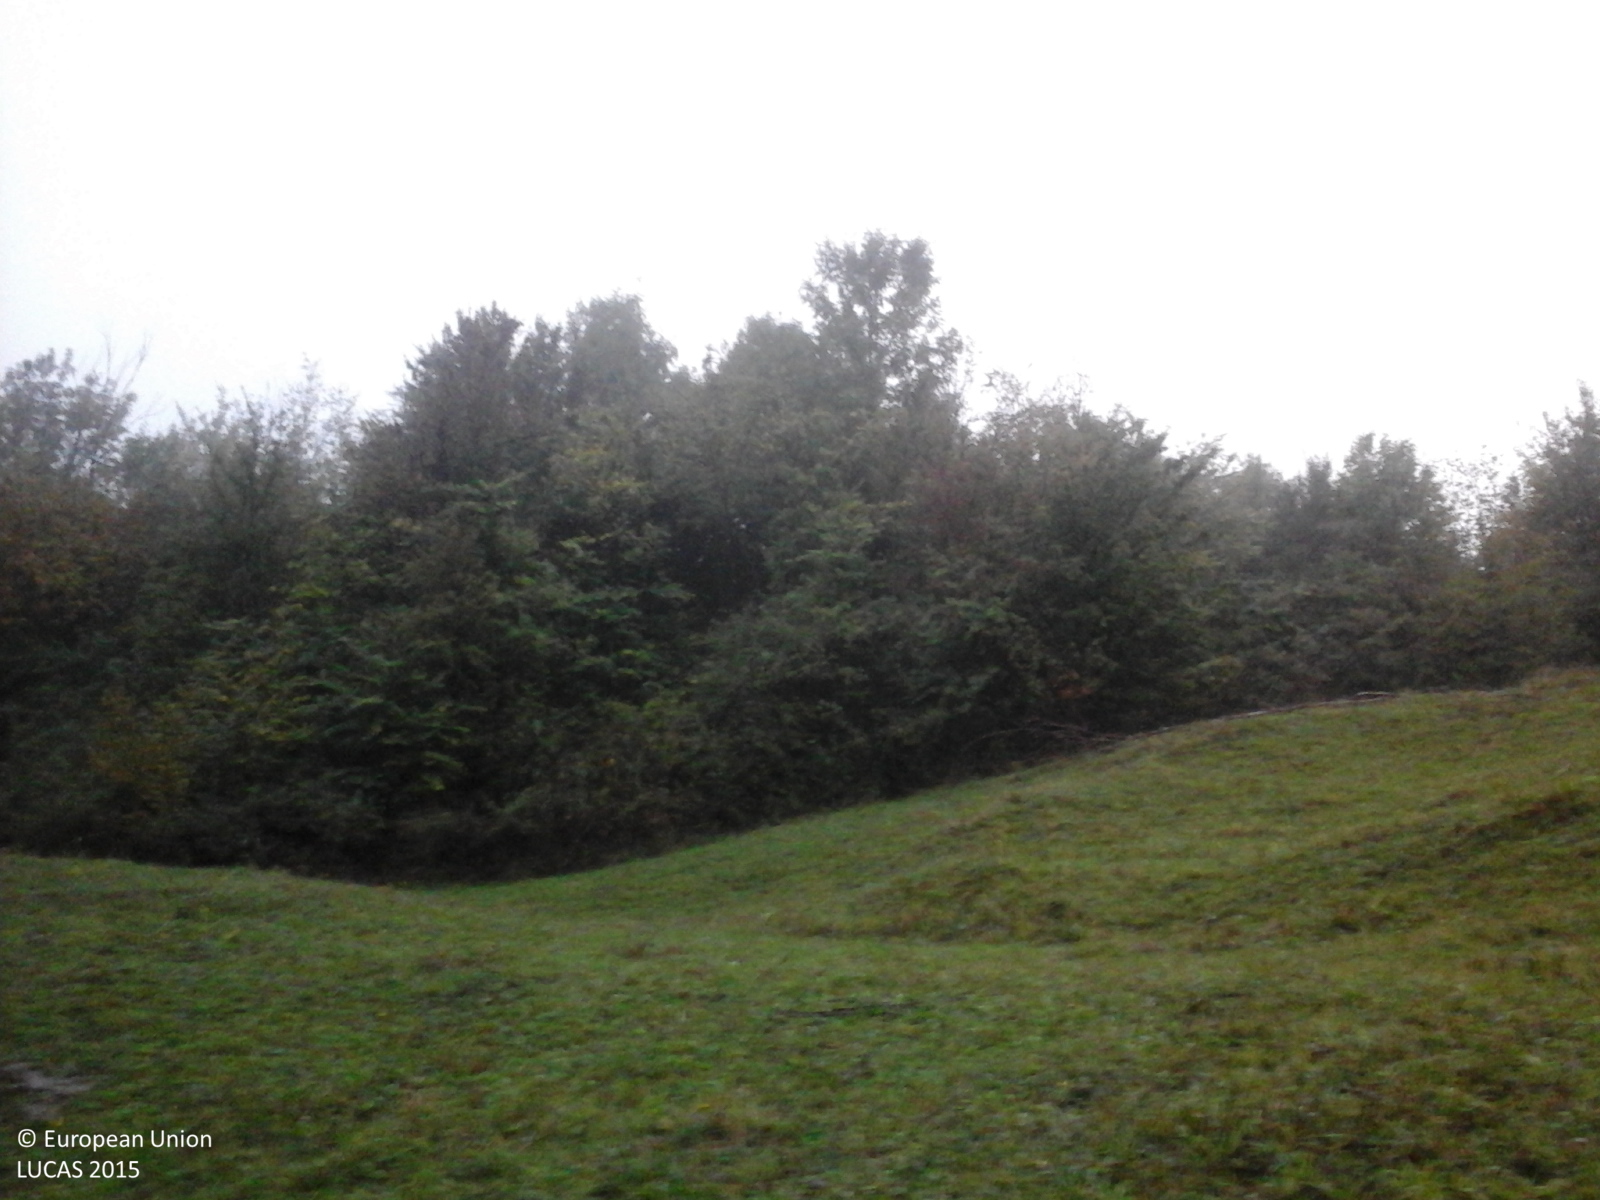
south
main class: Grassland
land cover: Grassland without tree/shrub cover
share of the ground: > 75 %
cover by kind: herbaceous plants 100 %
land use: Agriculture (excluding fallow land and kitchen gardens)
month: September
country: RO
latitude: 45.0998
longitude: 23.6971
